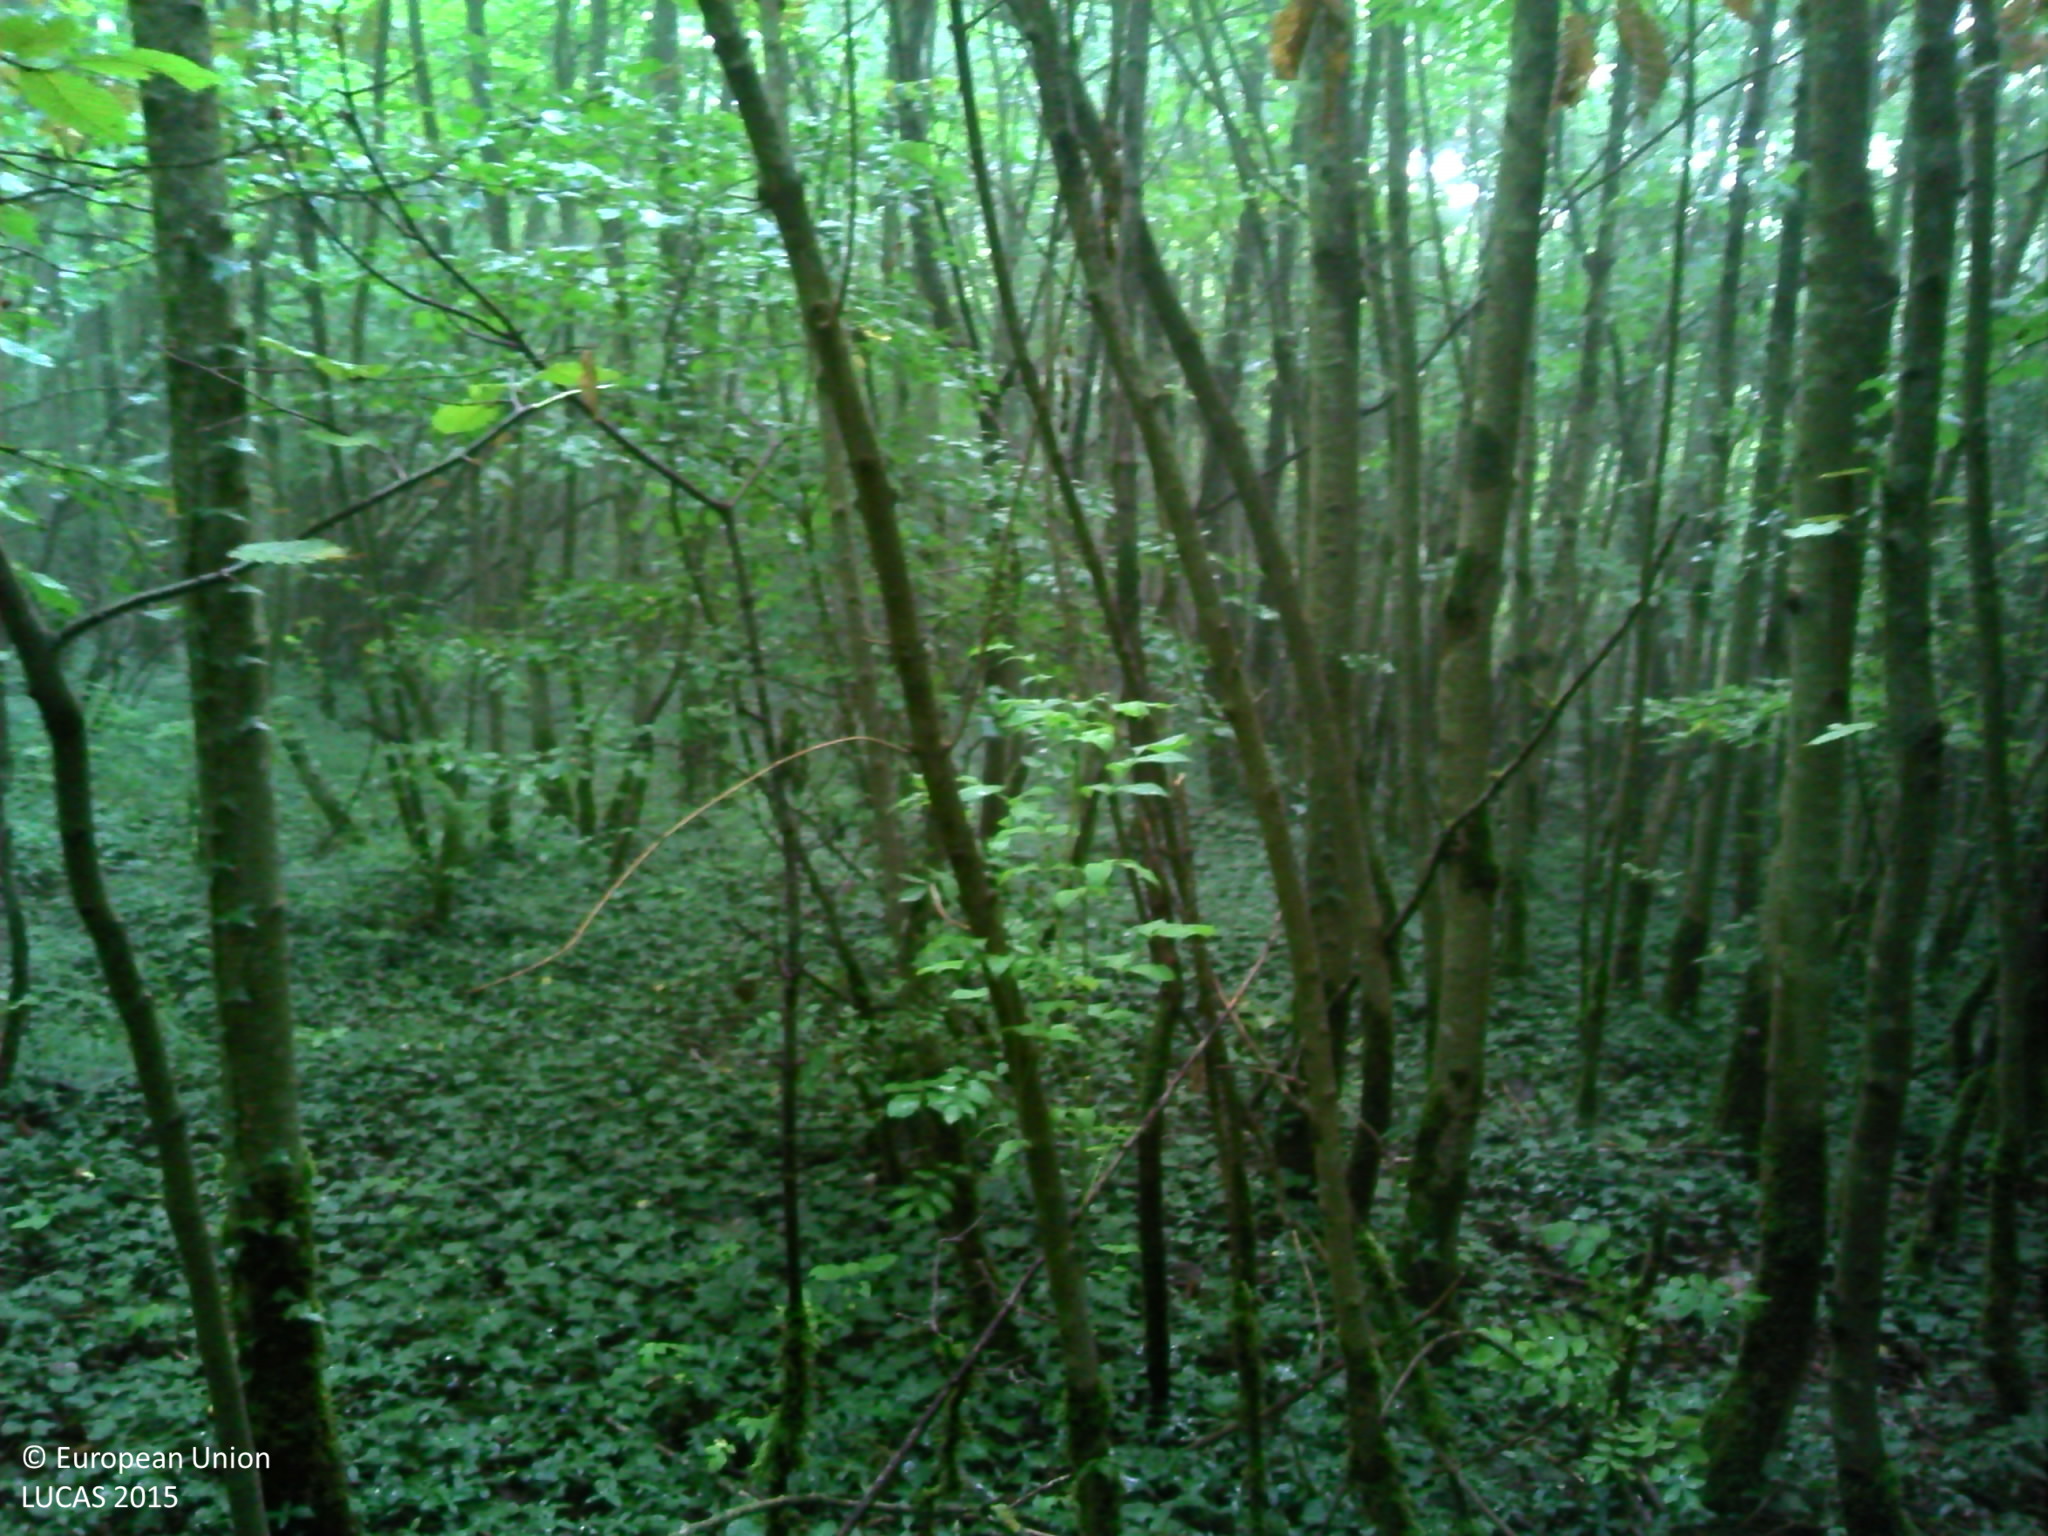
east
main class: Woodland
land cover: Broadleaved woodland
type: mesophytic deciduous forest
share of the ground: > 75 %
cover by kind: broadleaved forest trees 90 %, herbaceous plants 5 %, consolidated bare surface 5 %
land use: Forestry
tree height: > 5 m
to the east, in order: Broadleaved woodland; Tracks; Broadleaved woodland; Tracks; Broadleaved woodland; Tracks; Broadleaved woodland
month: September
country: FR
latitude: 49.2508
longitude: 6.0291
